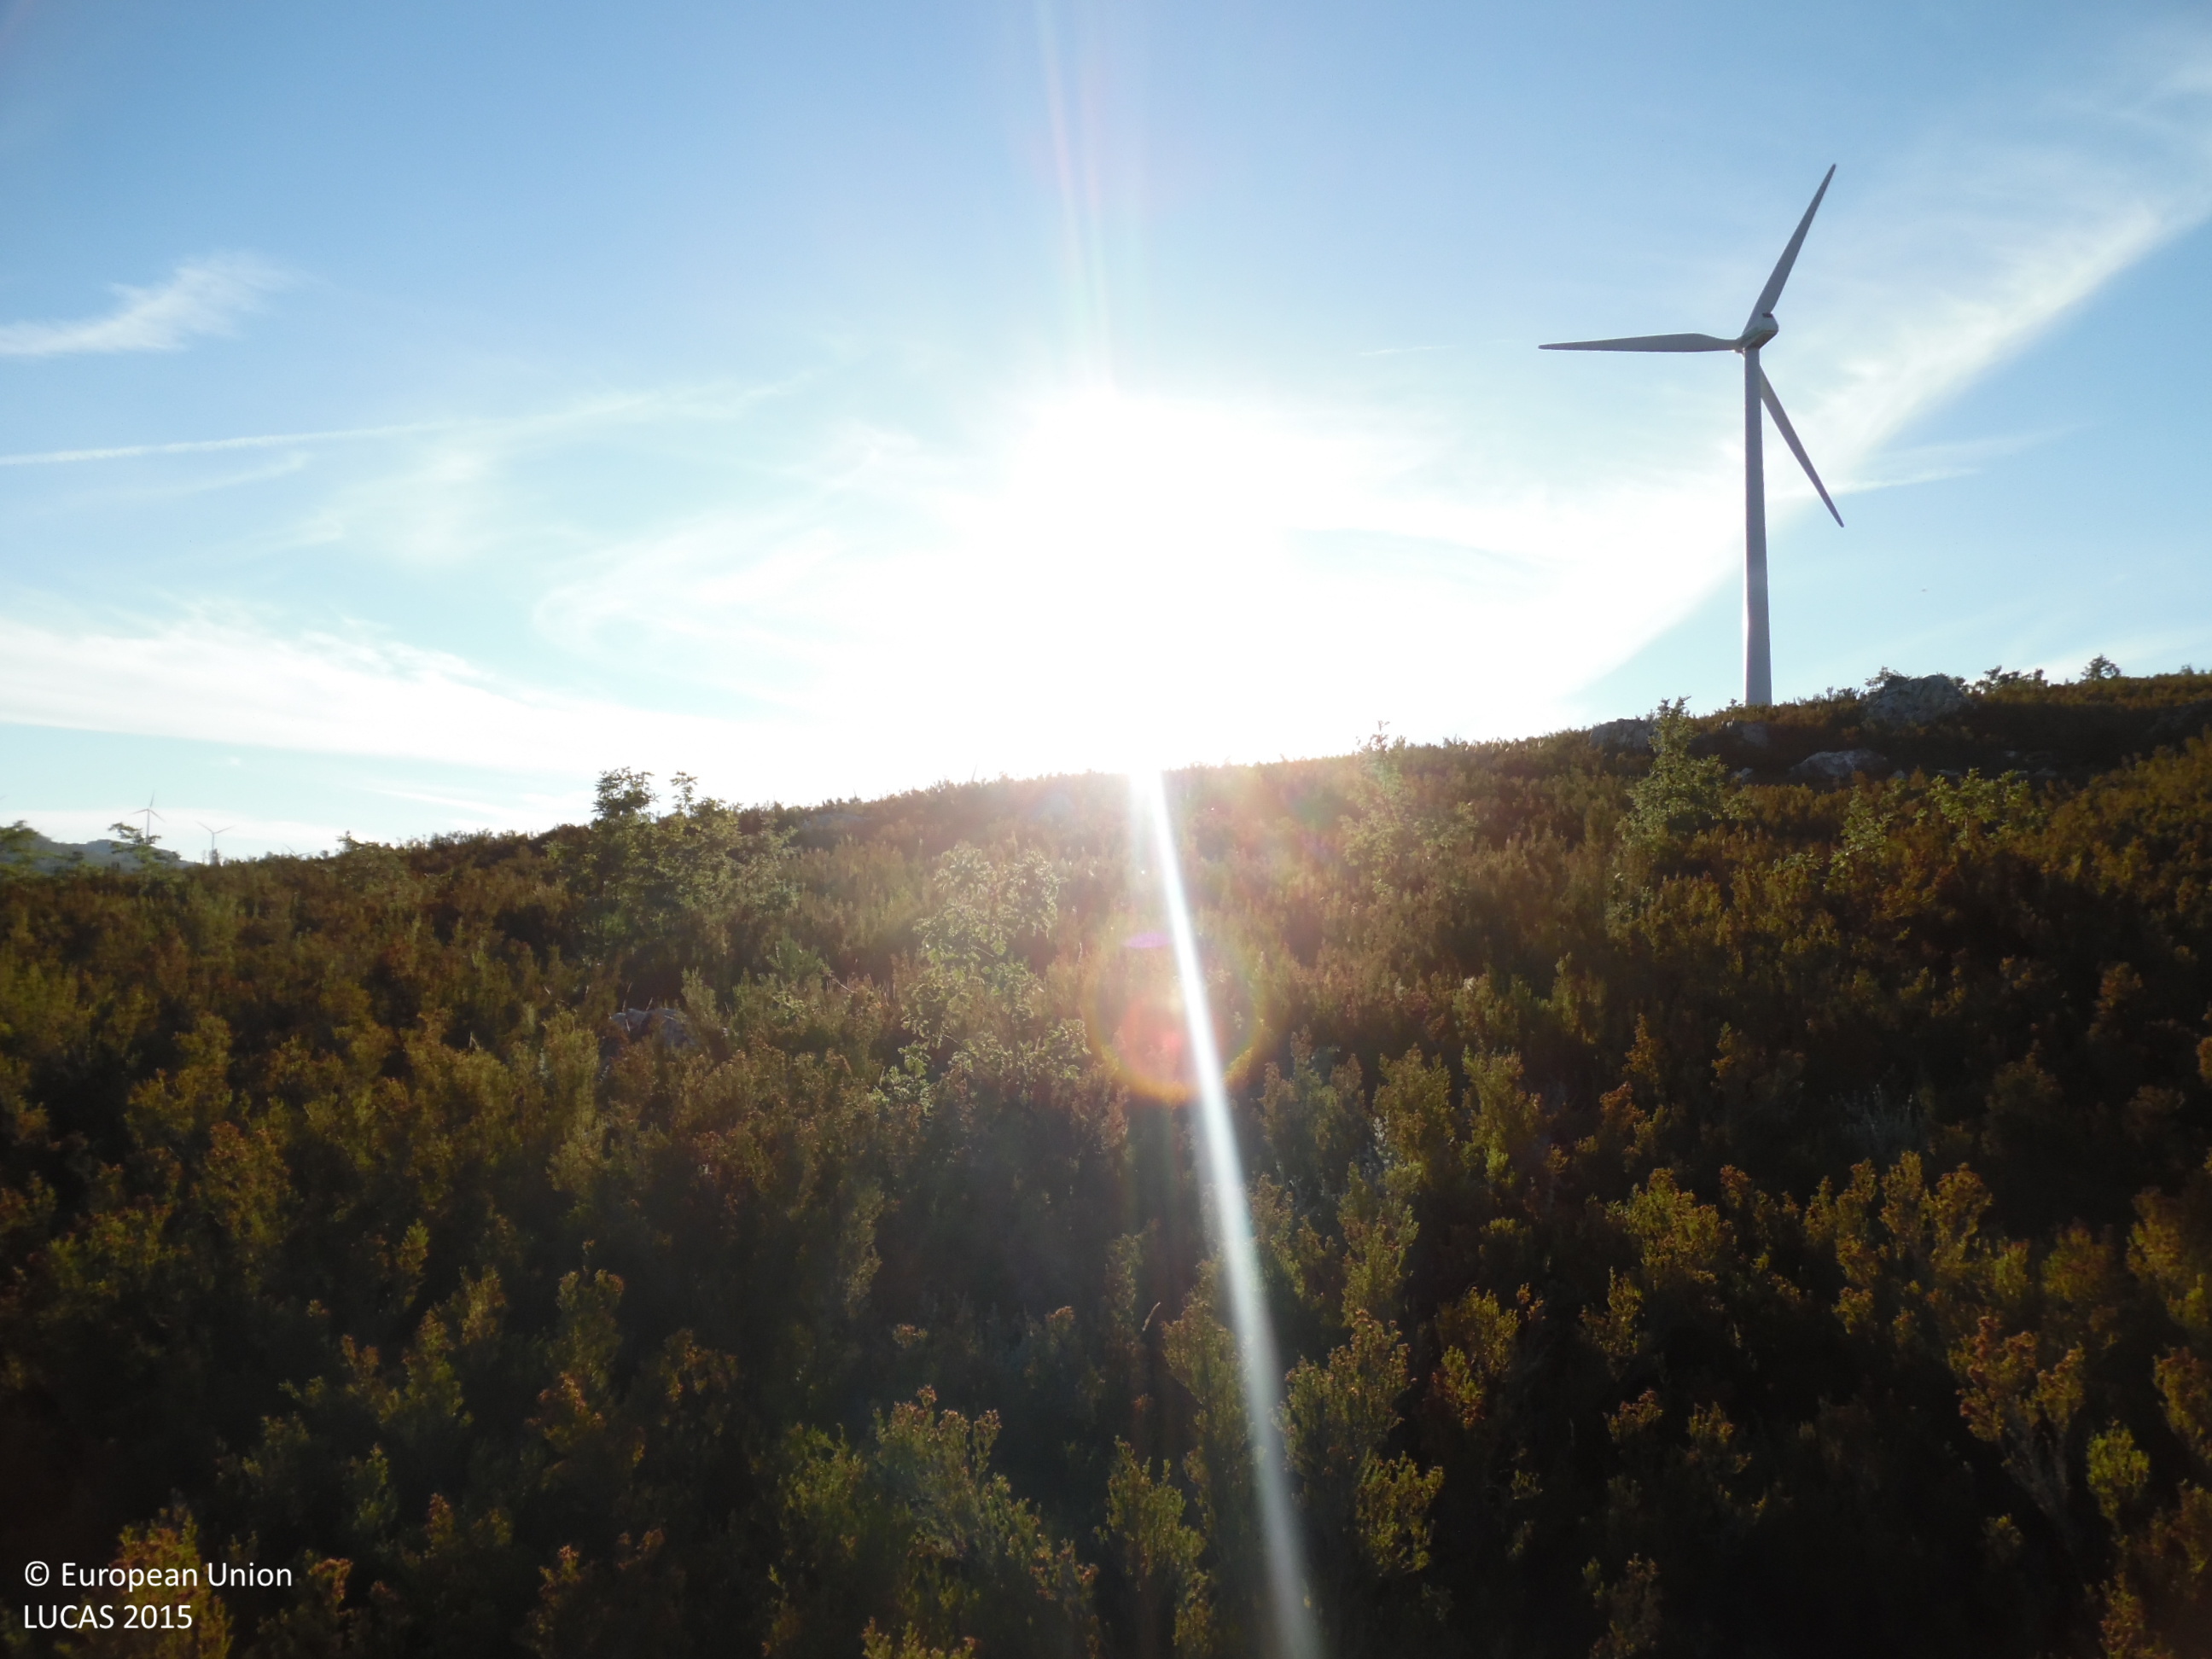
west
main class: Shrubland
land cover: Shrubland without tree cover
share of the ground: > 75 %
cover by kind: shrubs 100 %
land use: Forestry
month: July
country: ES
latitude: 42.5572
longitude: -6.3992
